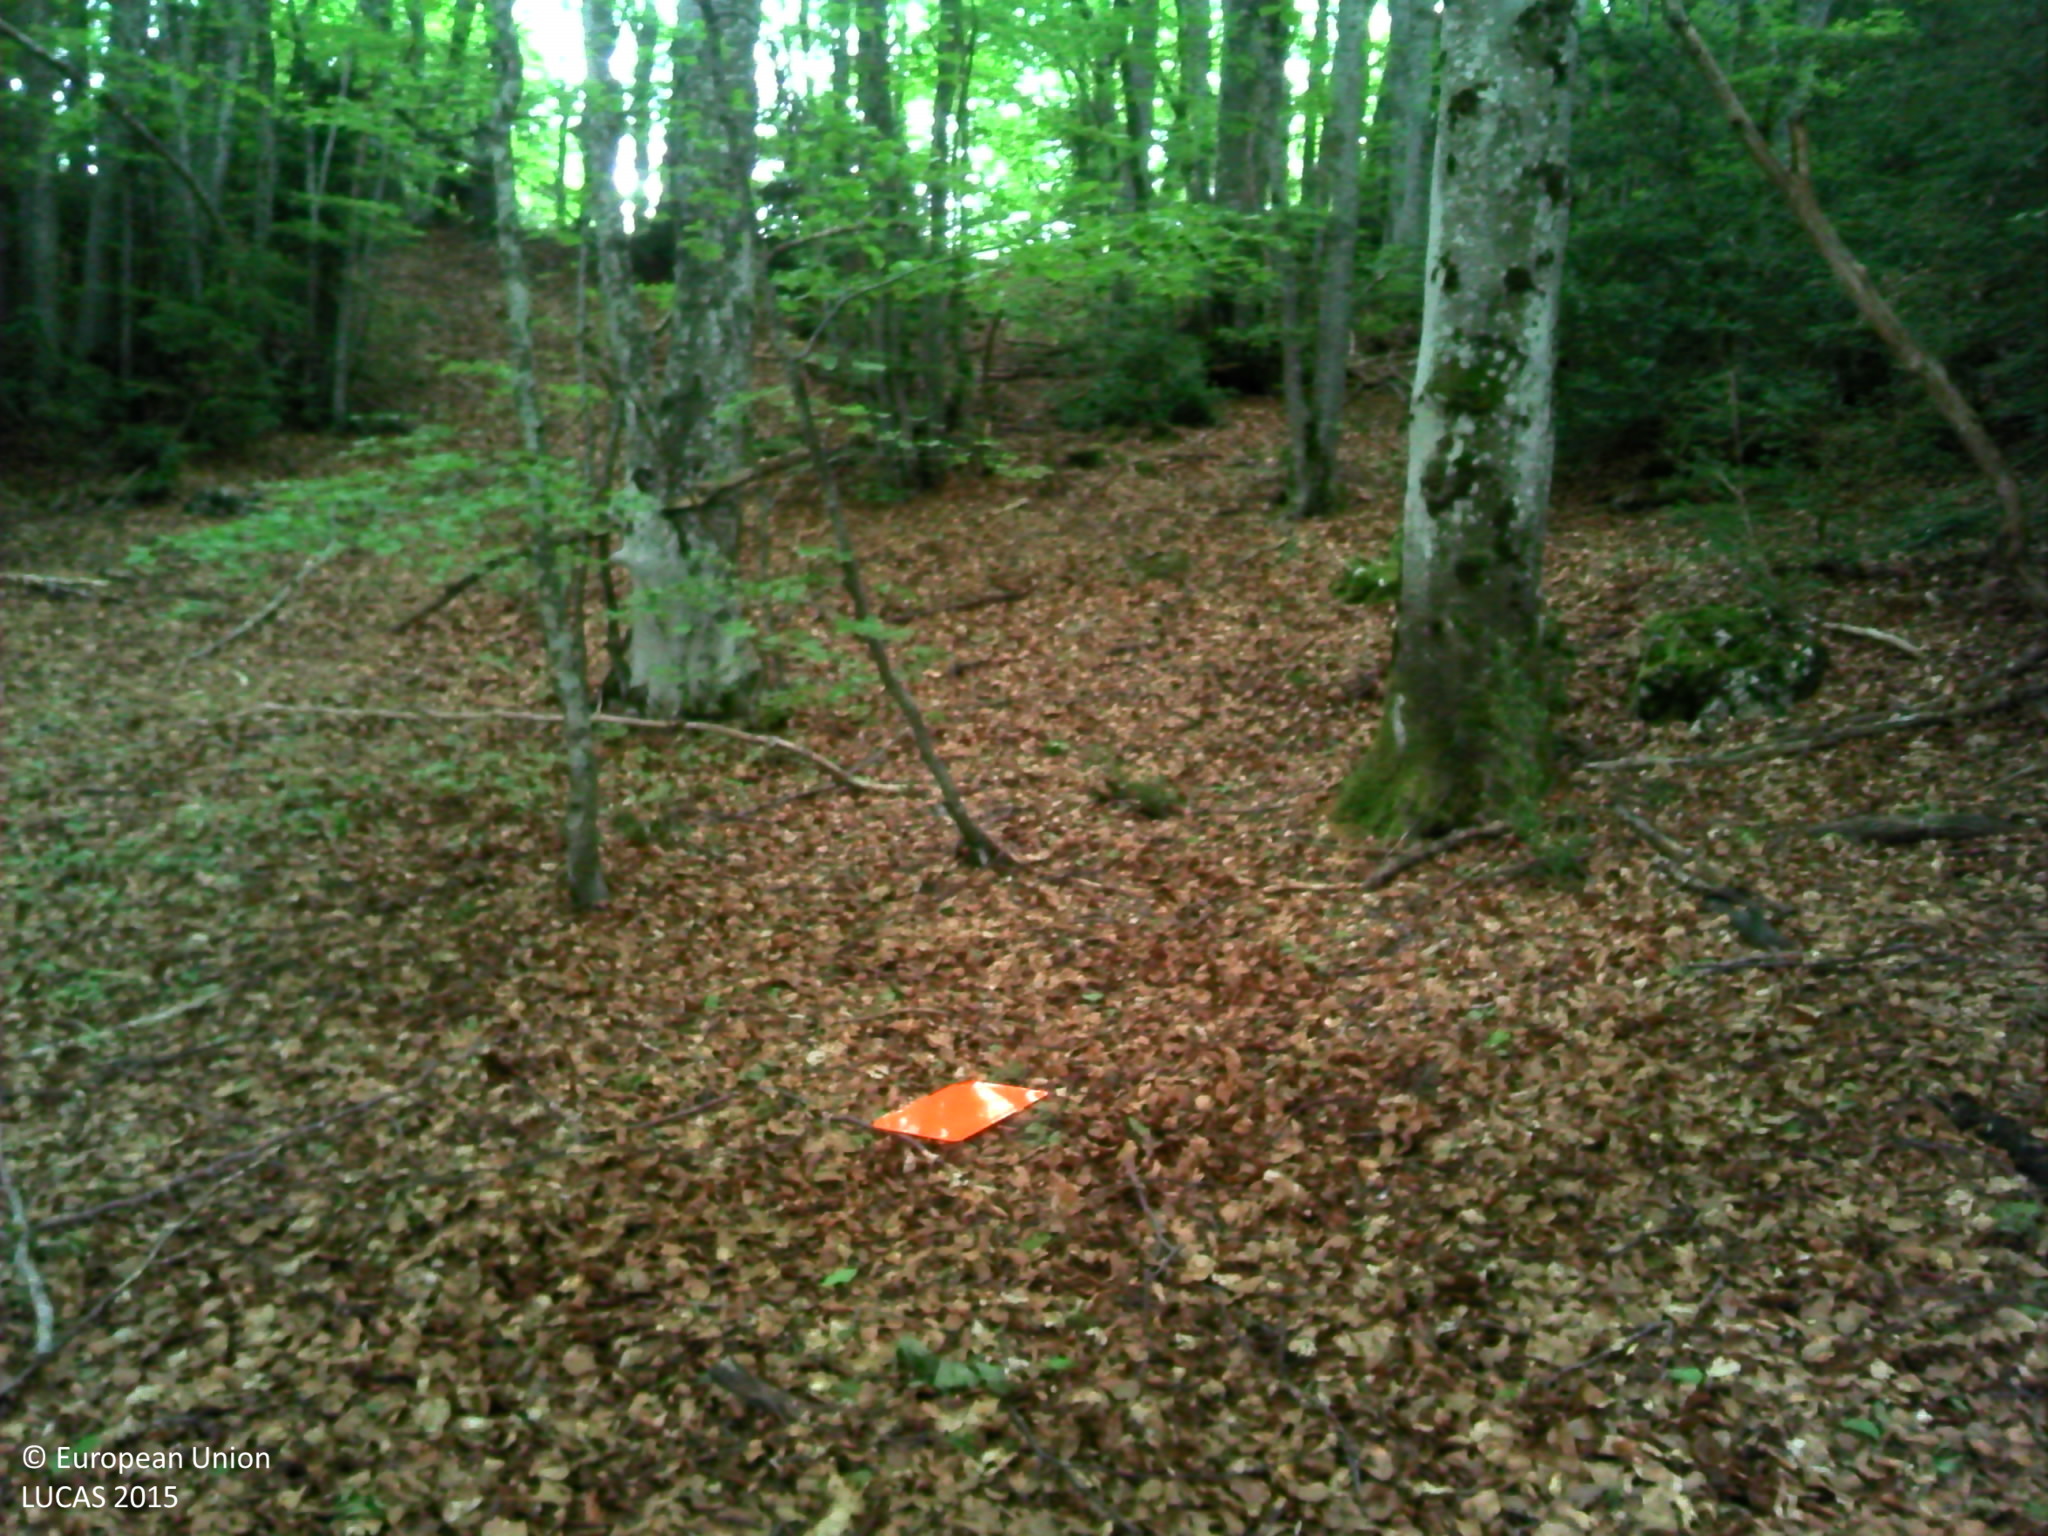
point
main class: Woodland
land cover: Broadleaved woodland
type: beech forest
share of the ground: > 75 %
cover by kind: broadleaved forest trees 95 %, lichens and mosses 5 %
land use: Semi-natural and natural areas not in use
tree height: > 5 m
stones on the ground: < 10 %
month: May
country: FR
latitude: 44.8877
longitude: 5.1568
